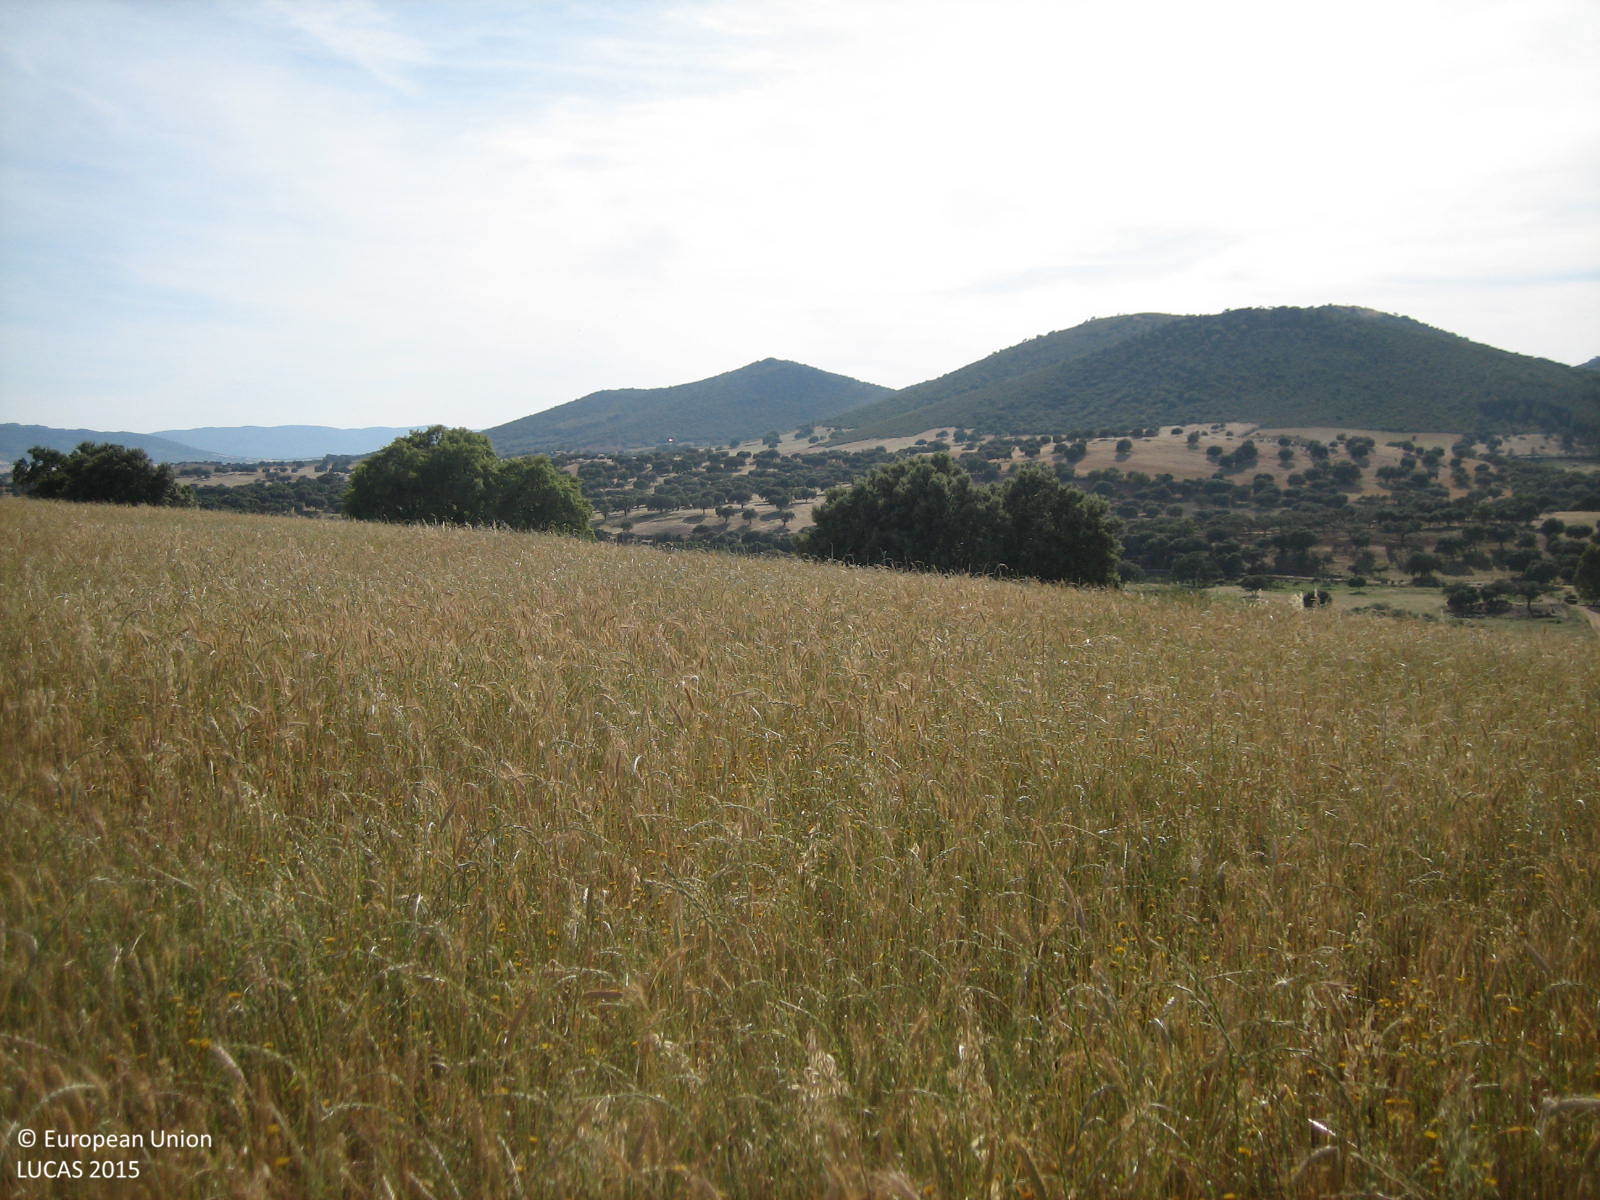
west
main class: Cropland
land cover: Mixed cereals for fodder
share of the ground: > 75 %
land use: Agriculture (excluding fallow land and kitchen gardens)
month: May
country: ES
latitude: 39.0444
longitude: -4.8109
